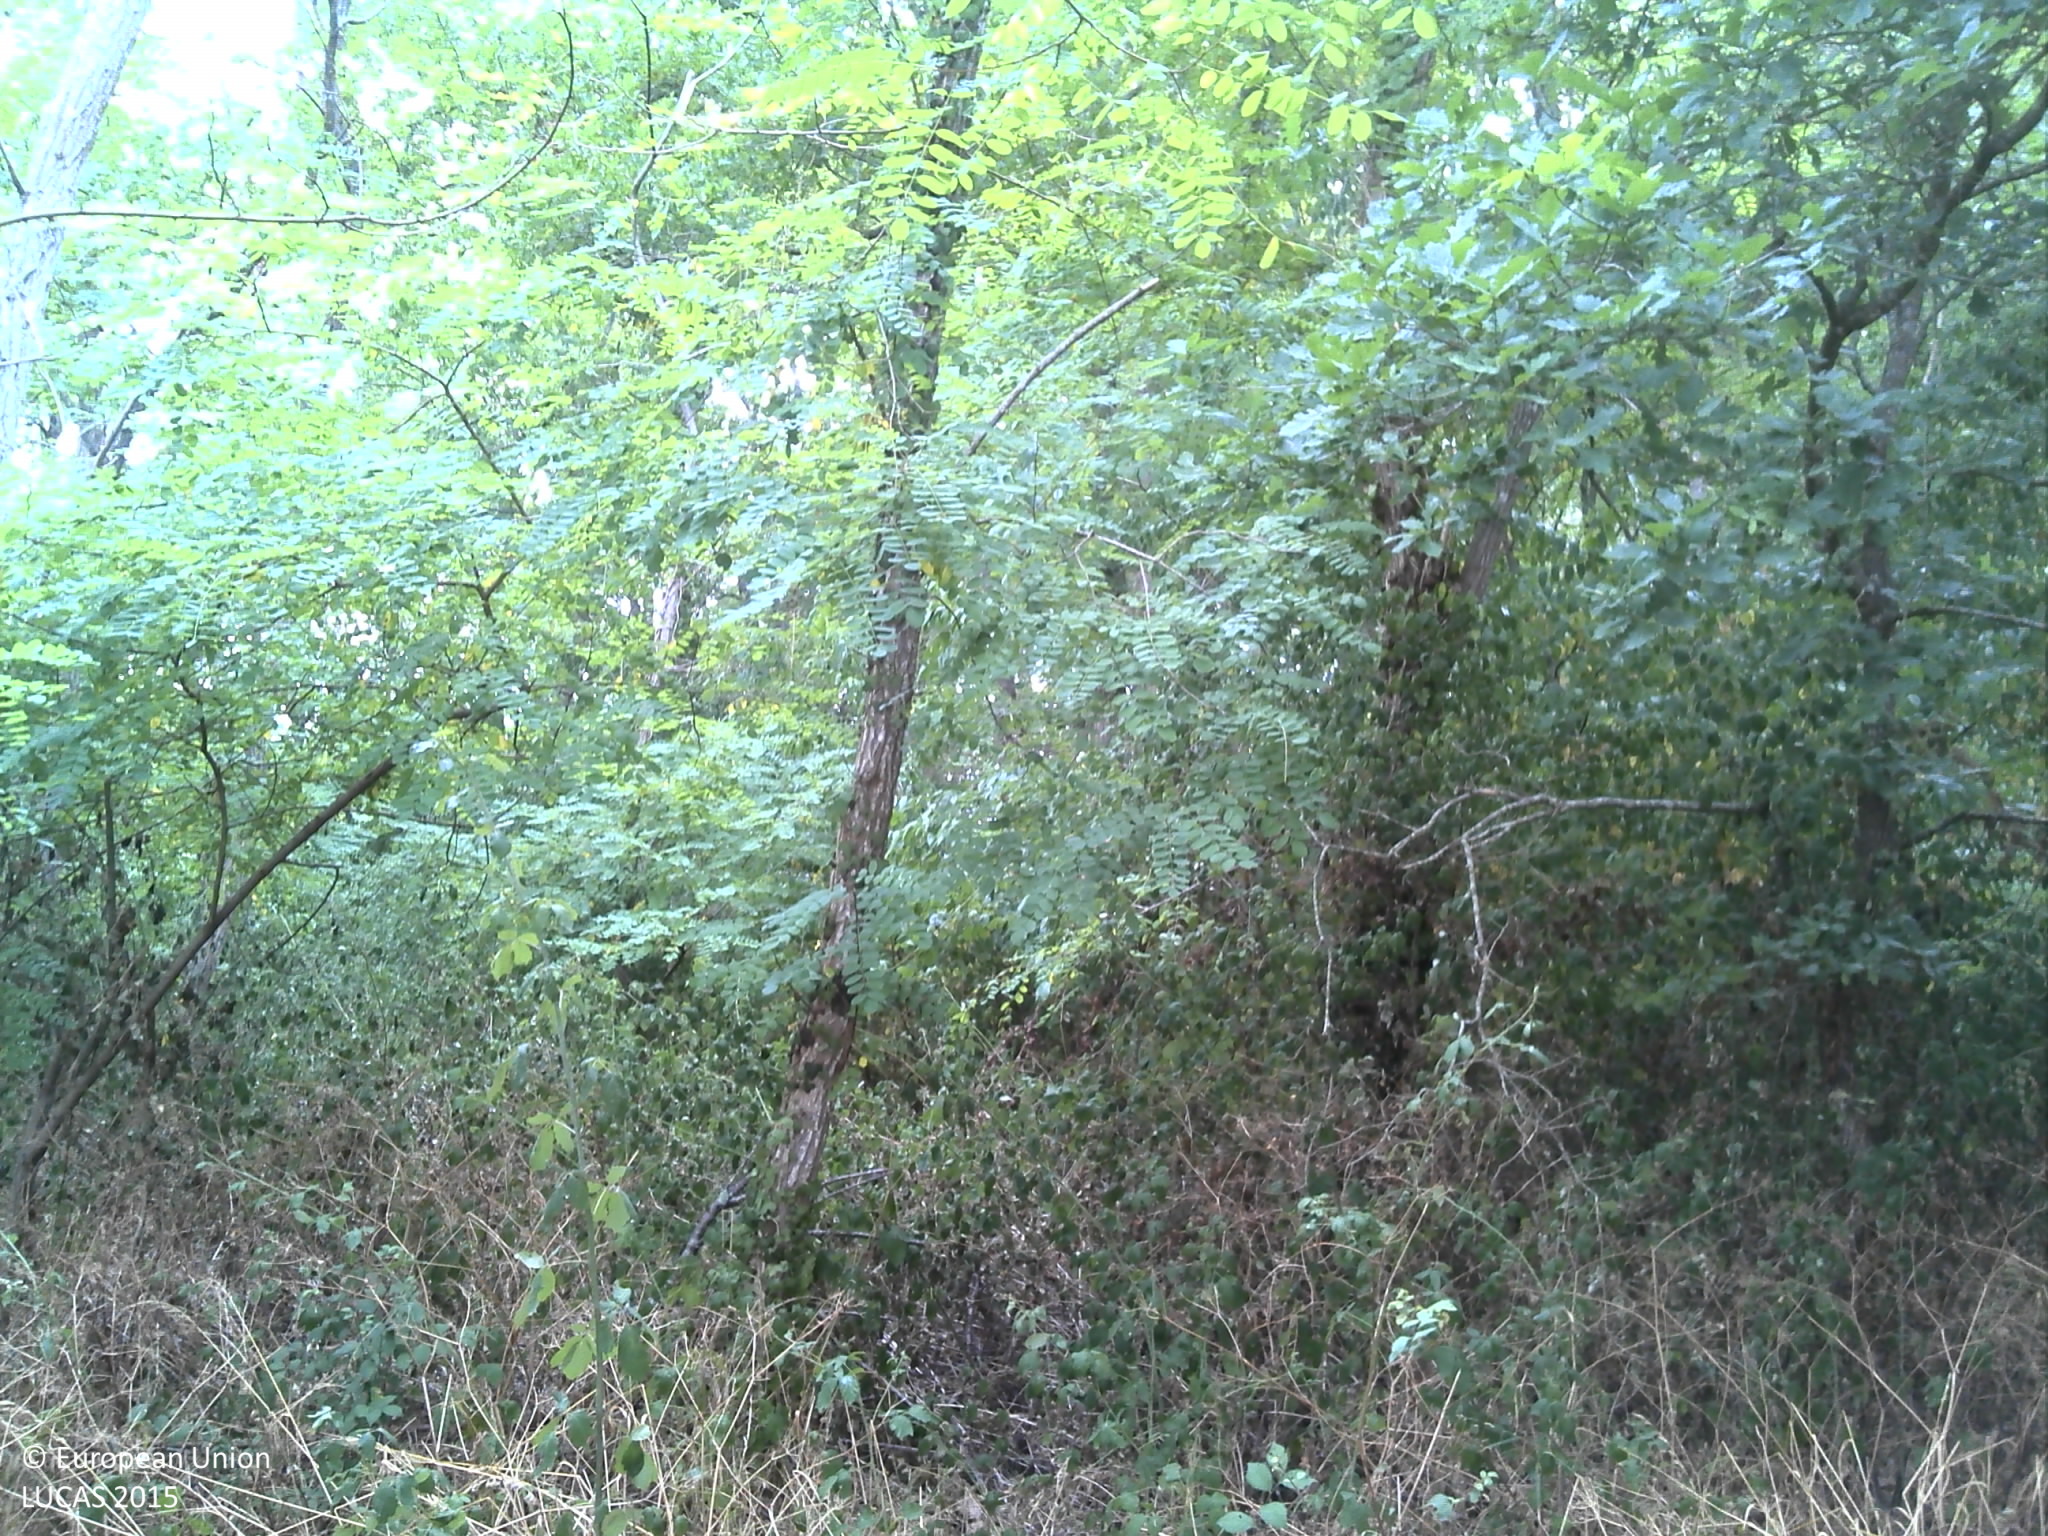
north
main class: Woodland
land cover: Broadleaved woodland
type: mesophytic deciduous forest
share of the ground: > 75 %
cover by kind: broadleaved forest trees 80 %, shrubs 10 %, herbaceous plants 5 %, lichens and mosses 5 %
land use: Semi-natural and natural areas not in use
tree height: > 5 m
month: July
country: FR
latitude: 44.6427
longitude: -0.5954
